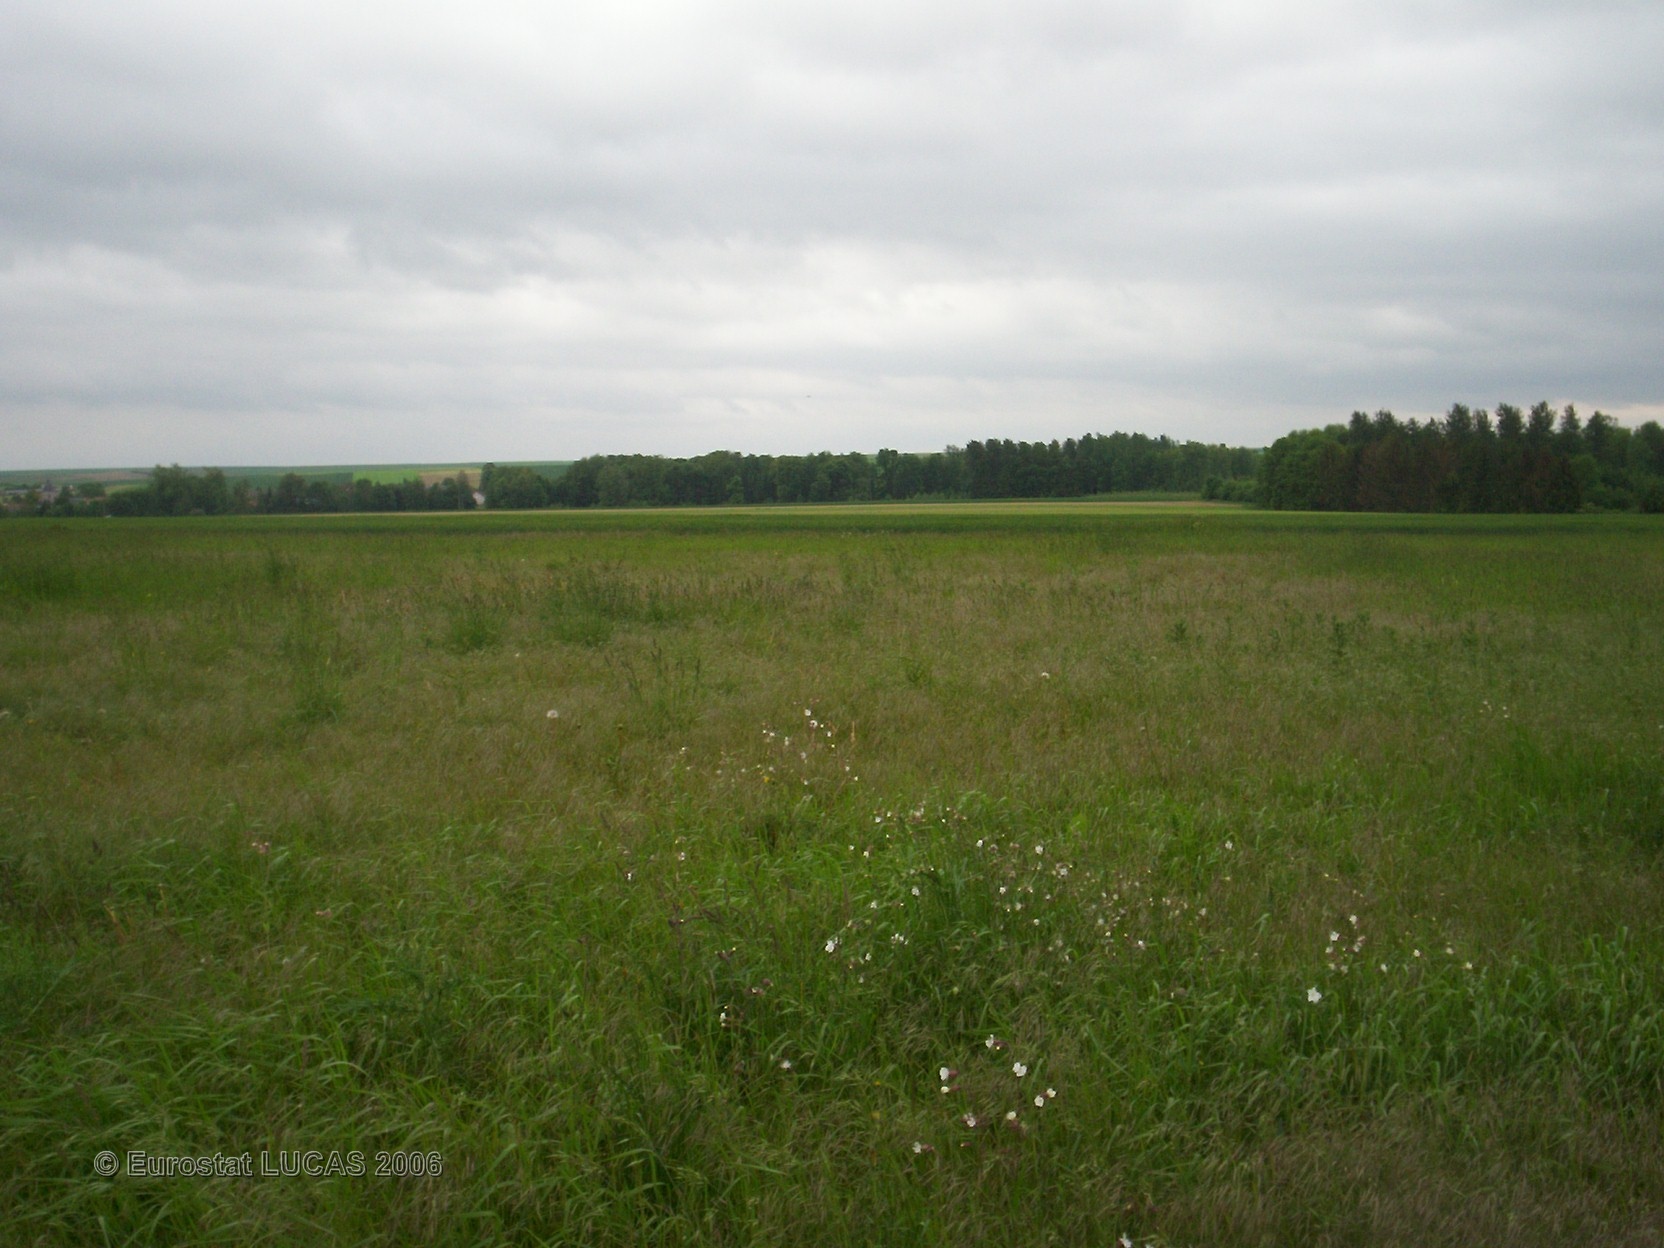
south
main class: Grassland
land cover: Grassland without tree/shrub cover
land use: Fallow land
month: May
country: FR
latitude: 49.3088
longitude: 4.4257
